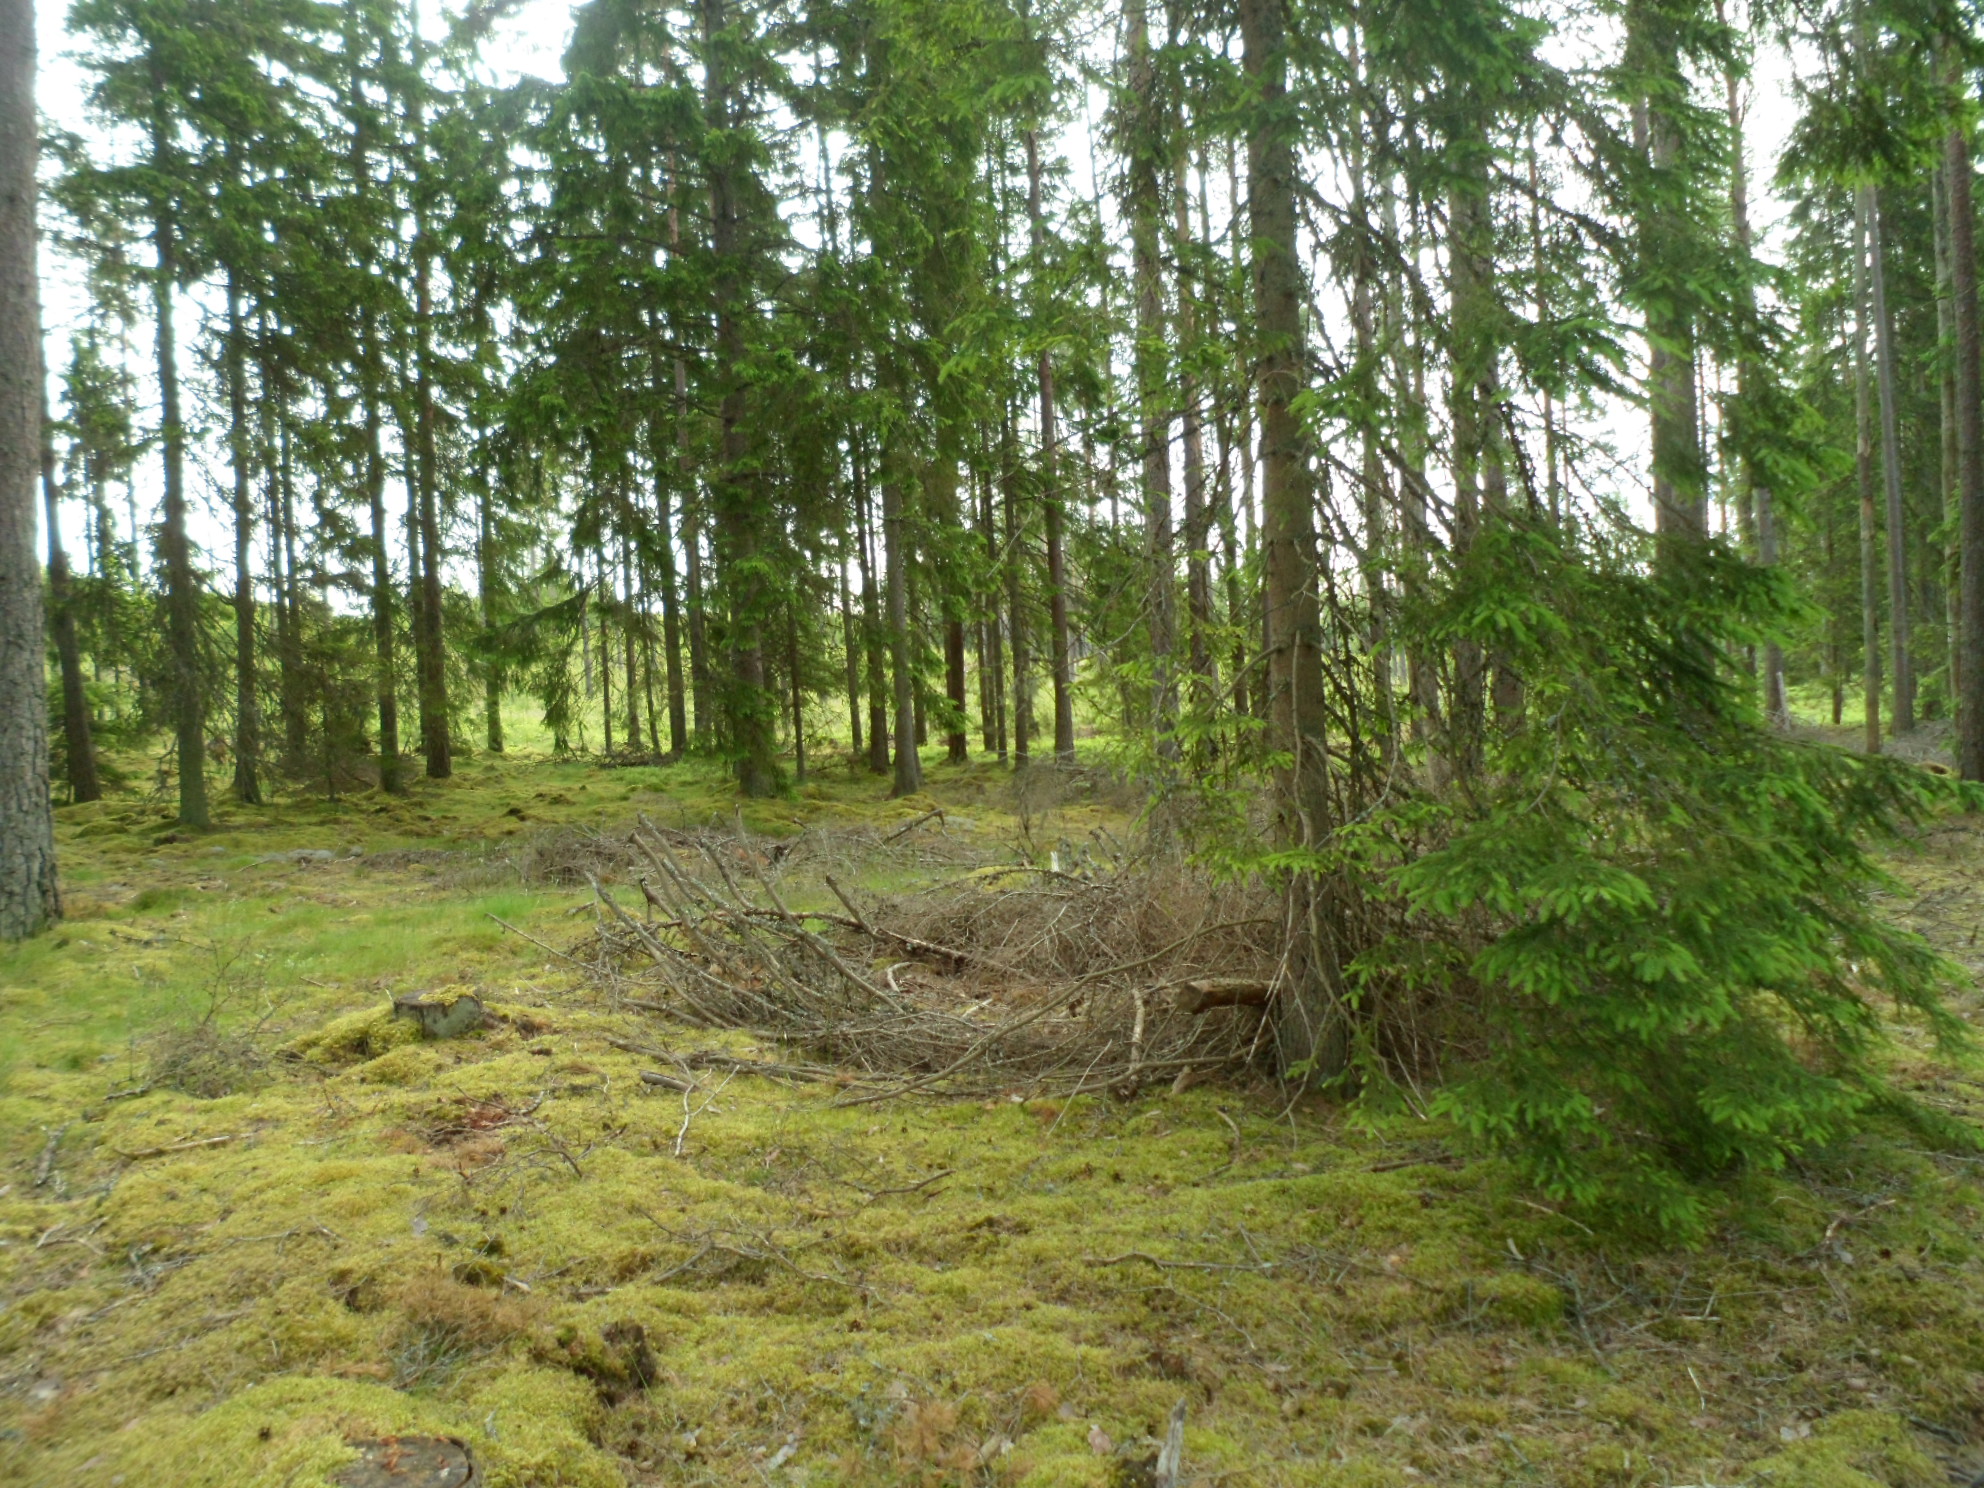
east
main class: Woodland
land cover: Pine dominated coniferous woodland
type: boreal forest
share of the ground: 25 - 50 %
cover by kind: coniferous forest trees 50 %, shrubs 20 %, lichens and mosses 20 %, herbaceous plants 10 %
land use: Forestry
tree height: > 5 m
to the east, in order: Pine dominated coniferous woodland; Pine dominated mixed woodland; Broadleaved woodland; Tracks; Broadleaved woodland
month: June
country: SE
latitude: 57.0187
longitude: 15.2187
